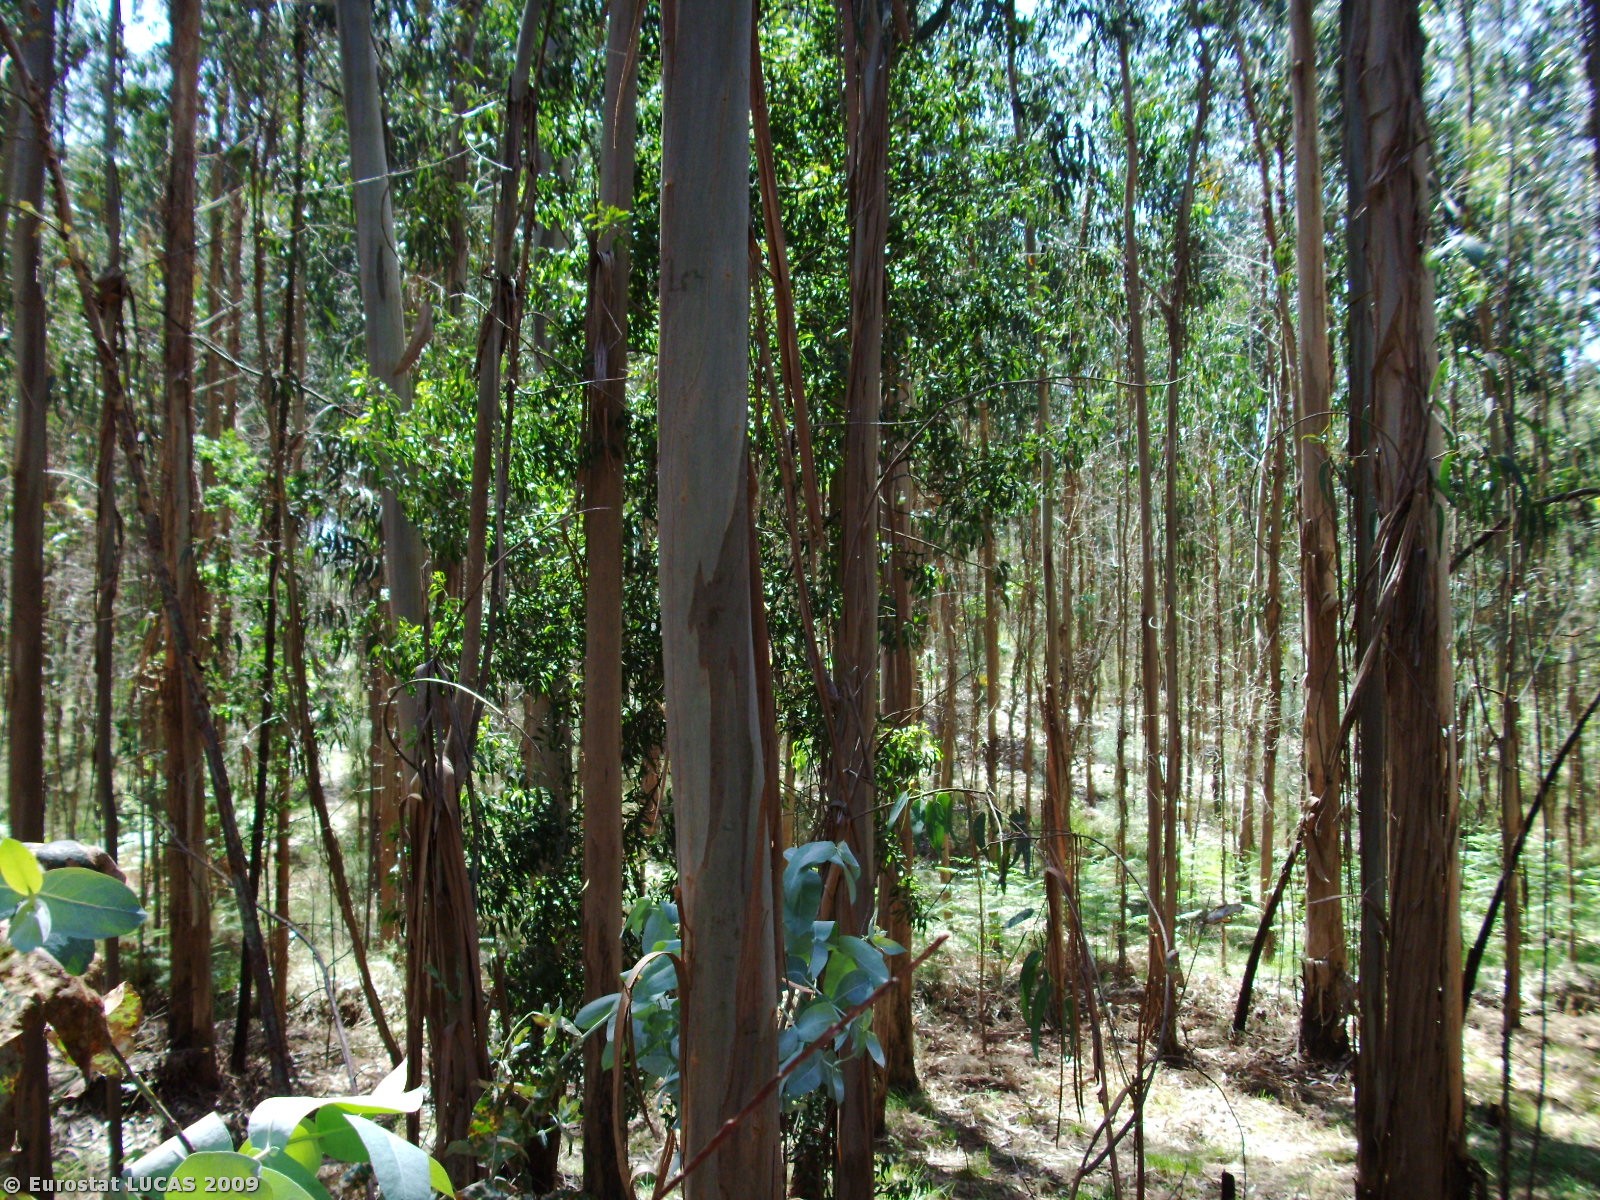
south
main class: Woodland
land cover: Mixed woodland
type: coniferous forest of the mediterranean region
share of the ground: > 75 %
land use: Forestry
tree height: > 5 m
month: May
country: PT
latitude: 40.7670
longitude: -8.4933
